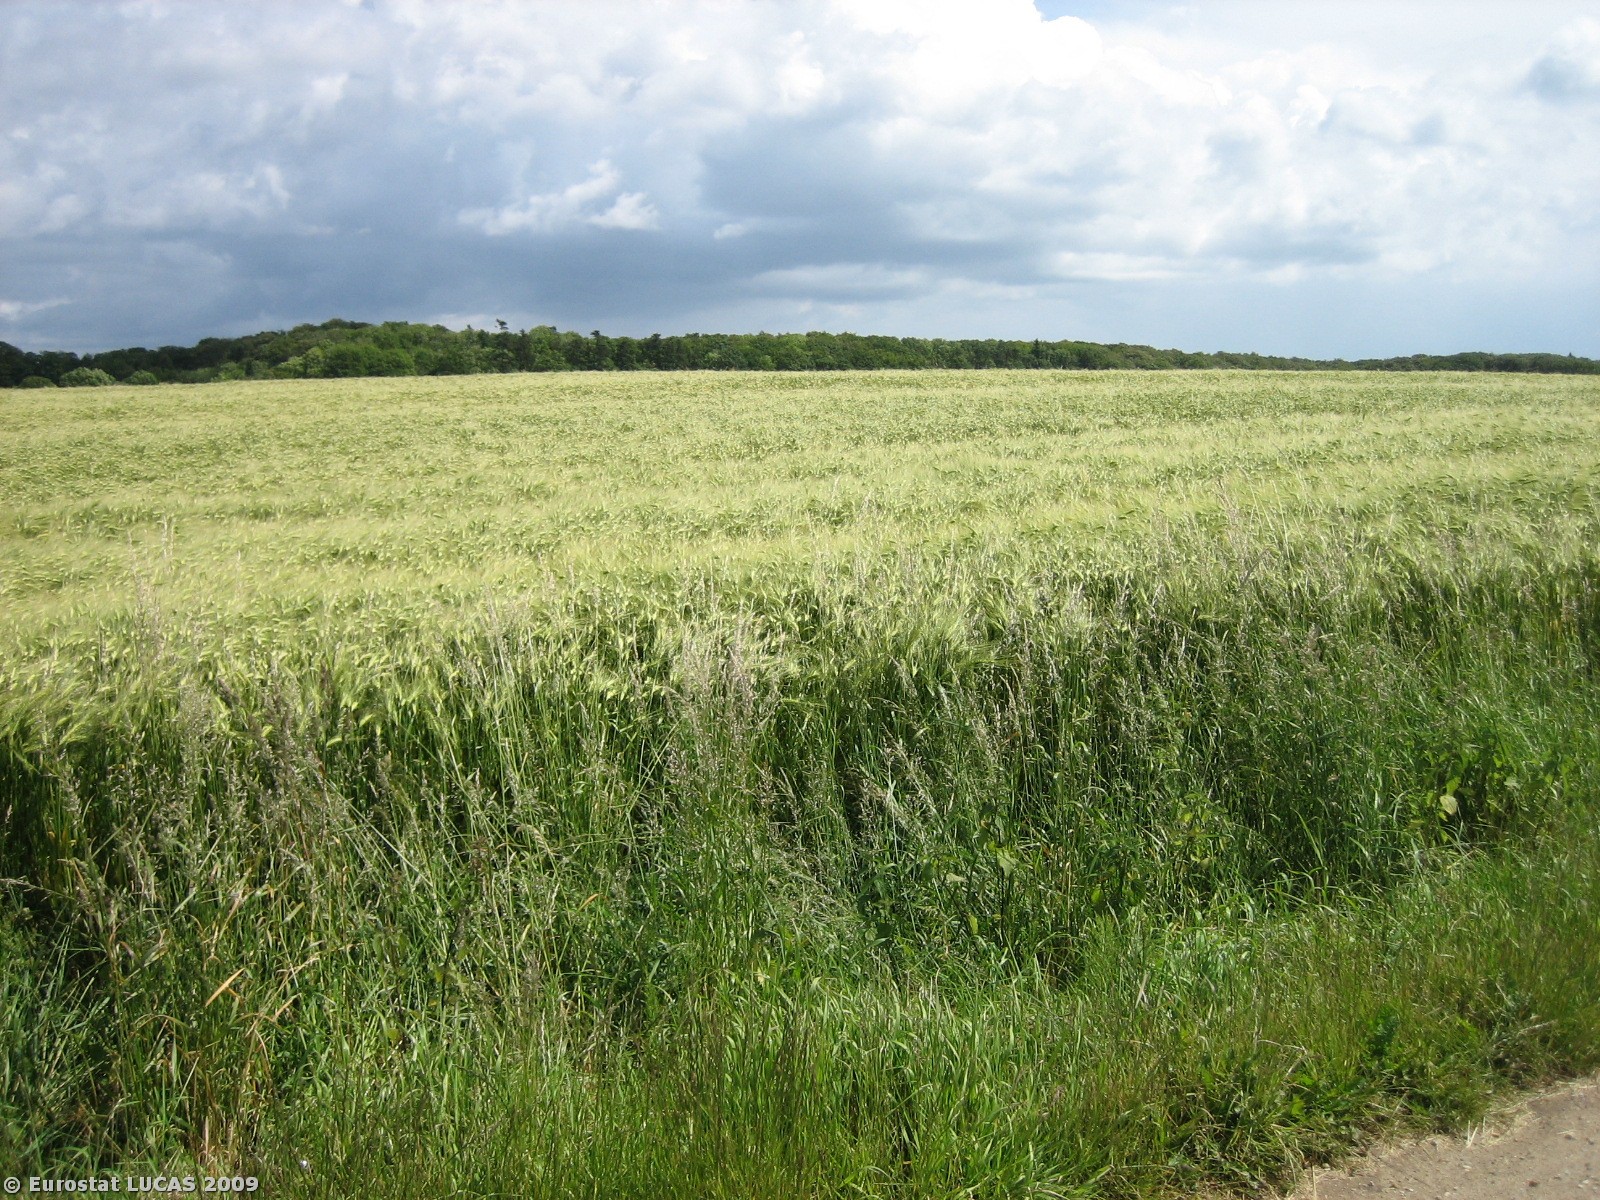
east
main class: Cropland
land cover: Common wheat
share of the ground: > 75 %
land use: Agriculture (excluding fallow land and kitchen gardens)
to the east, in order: Common wheat; Rape and turnip rape; Grass margins; Ditches and canals; Grass margins; Tracks; Grass margins; Barley
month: June
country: DK
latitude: 55.6124
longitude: 9.7938
